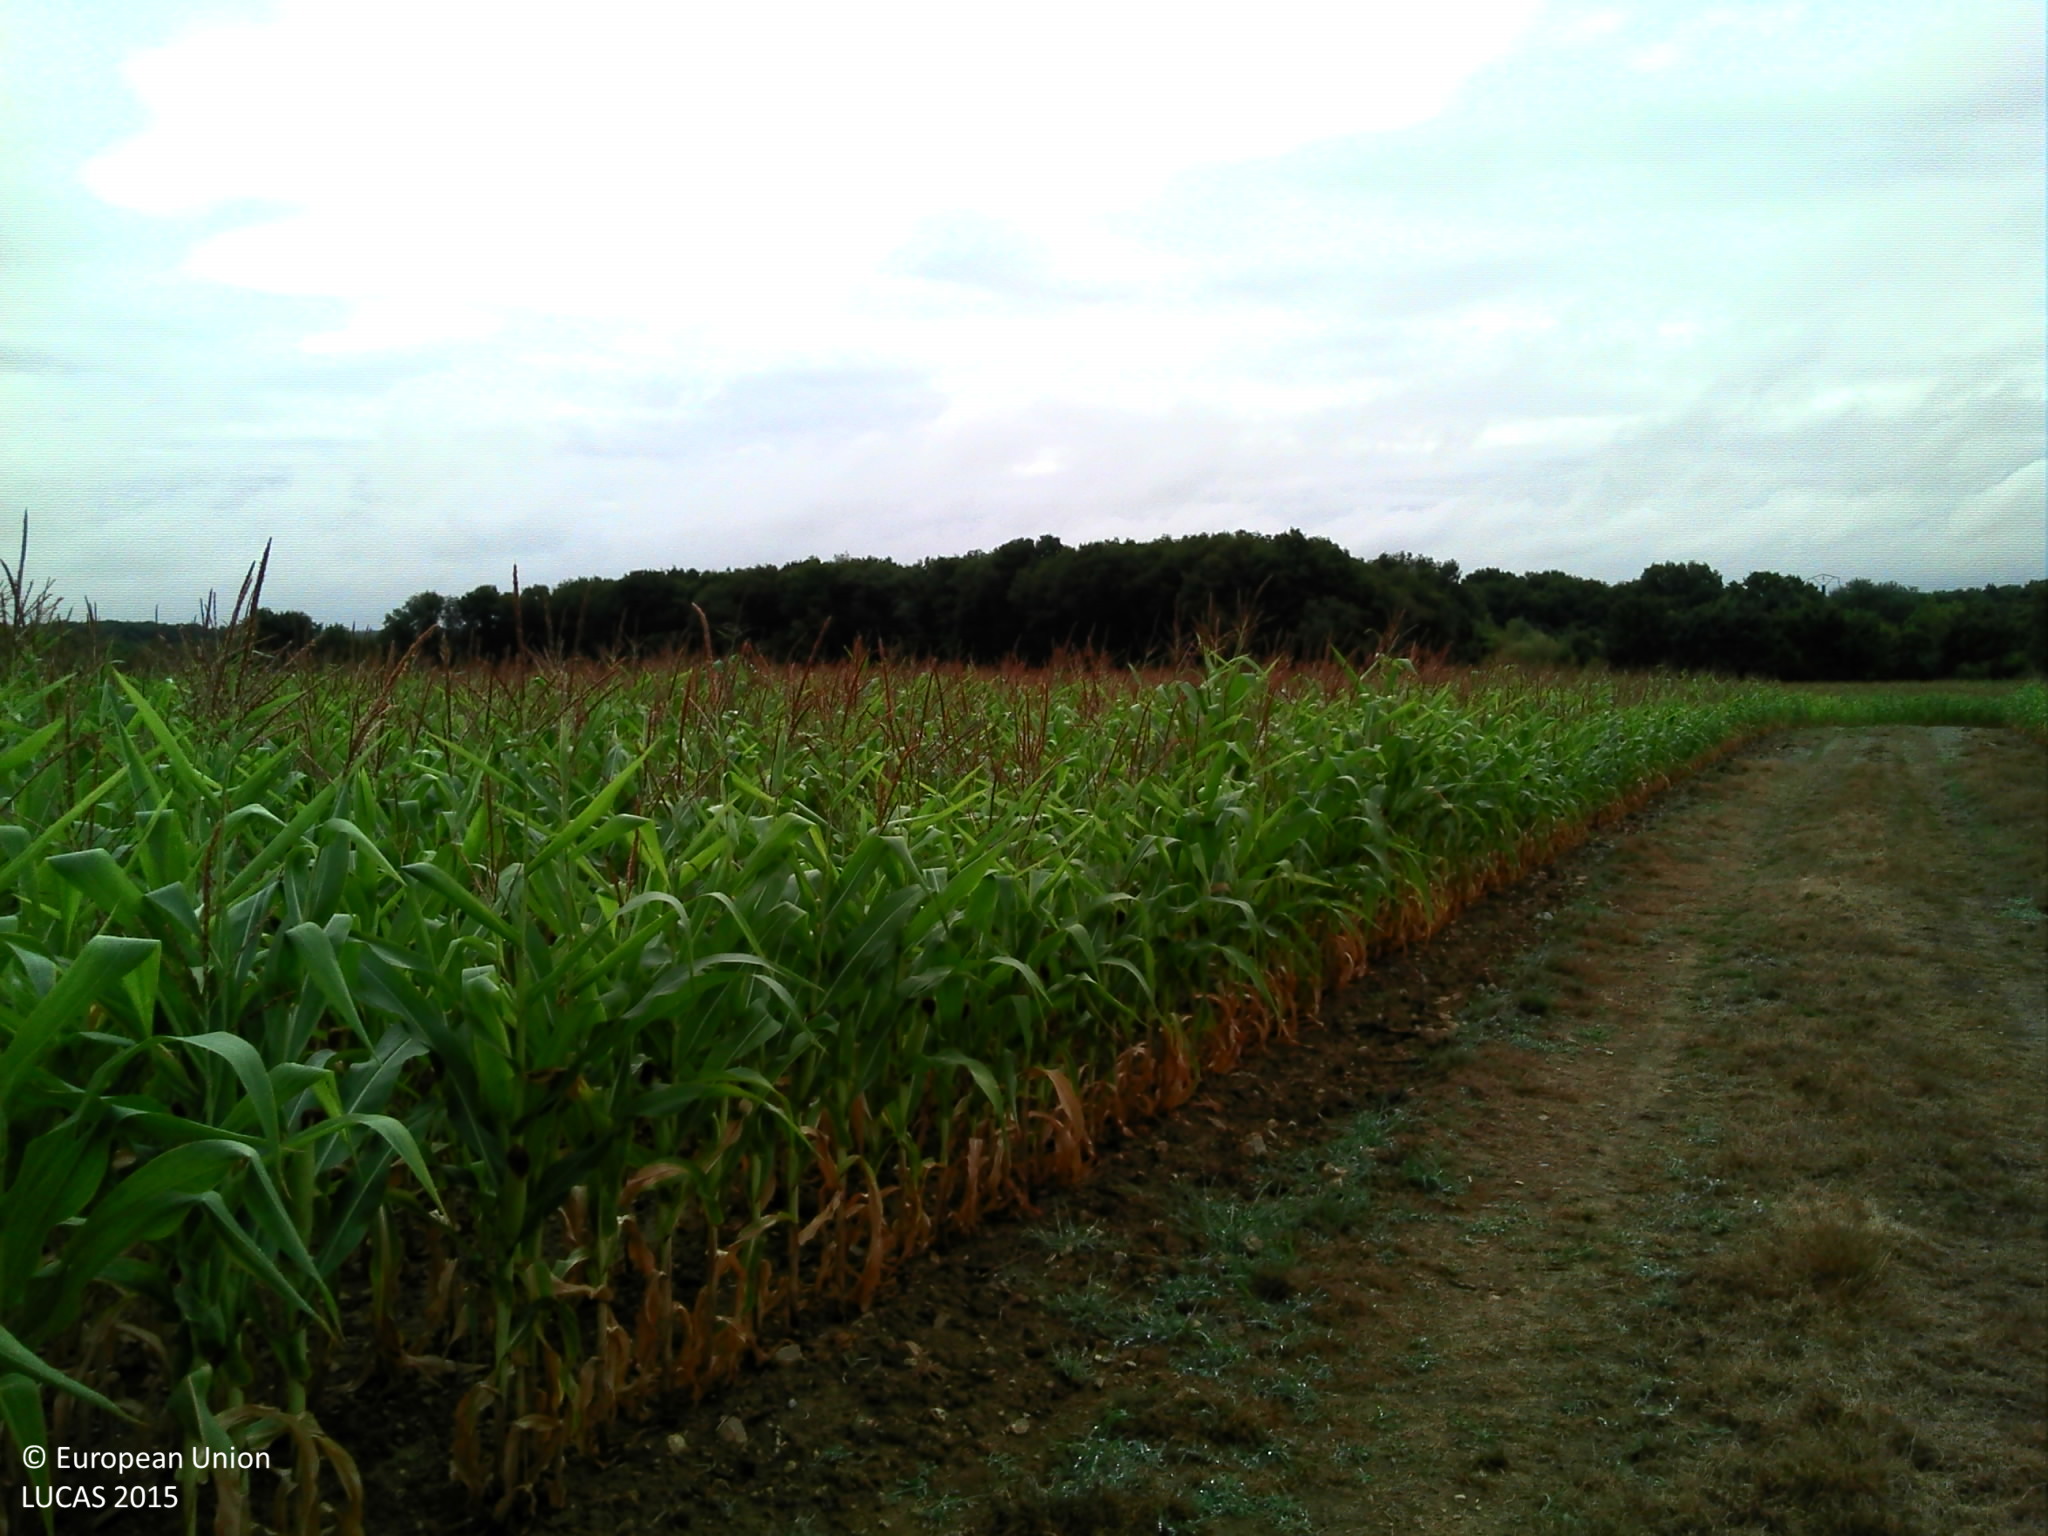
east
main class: Cropland
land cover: Maize
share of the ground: > 75 %
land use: Agriculture (excluding fallow land and kitchen gardens)
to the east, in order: Maize
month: July
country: FR
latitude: 46.4625
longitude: 0.2012
